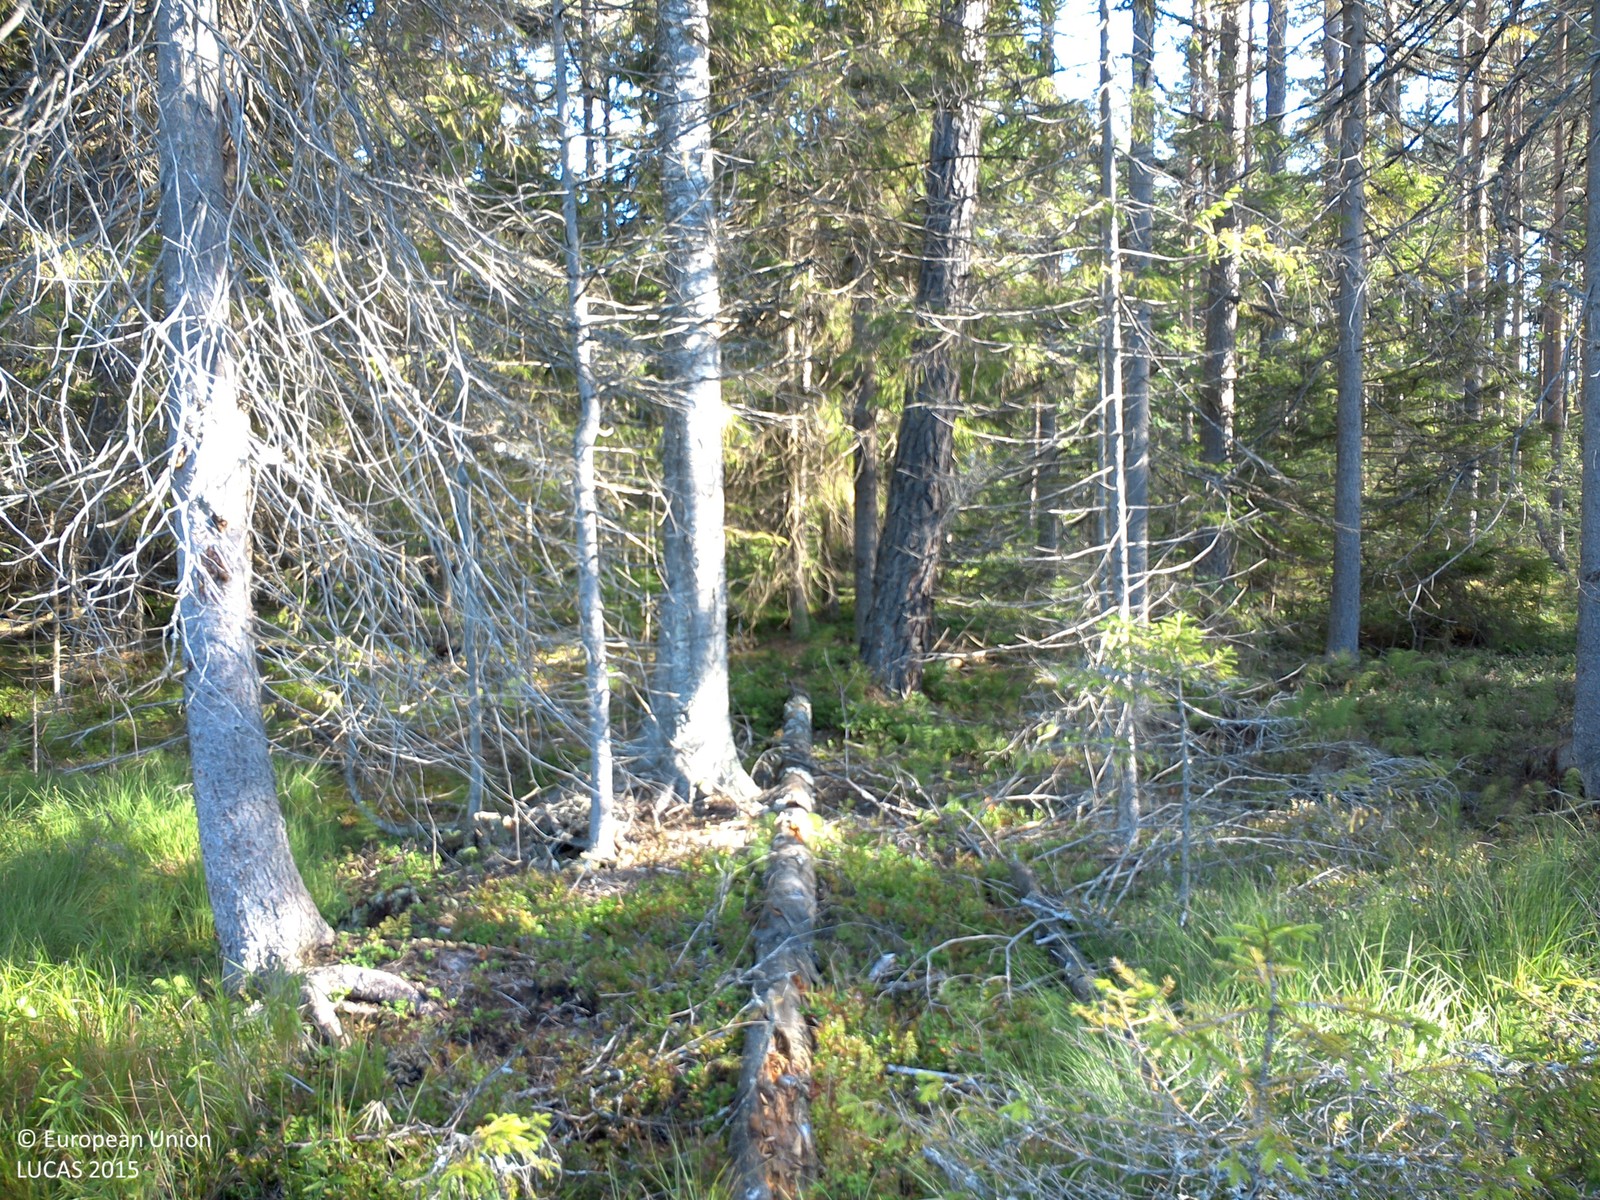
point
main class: Woodland
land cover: Pine dominated mixed woodland
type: boreal forest
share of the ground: 50 - 75 %
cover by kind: coniferous forest trees 50 %, herbaceous plants 30 %, broadleaved forest trees 20 %
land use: Forestry
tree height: > 5 m
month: August
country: SE
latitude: 58.1097
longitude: 14.9672
